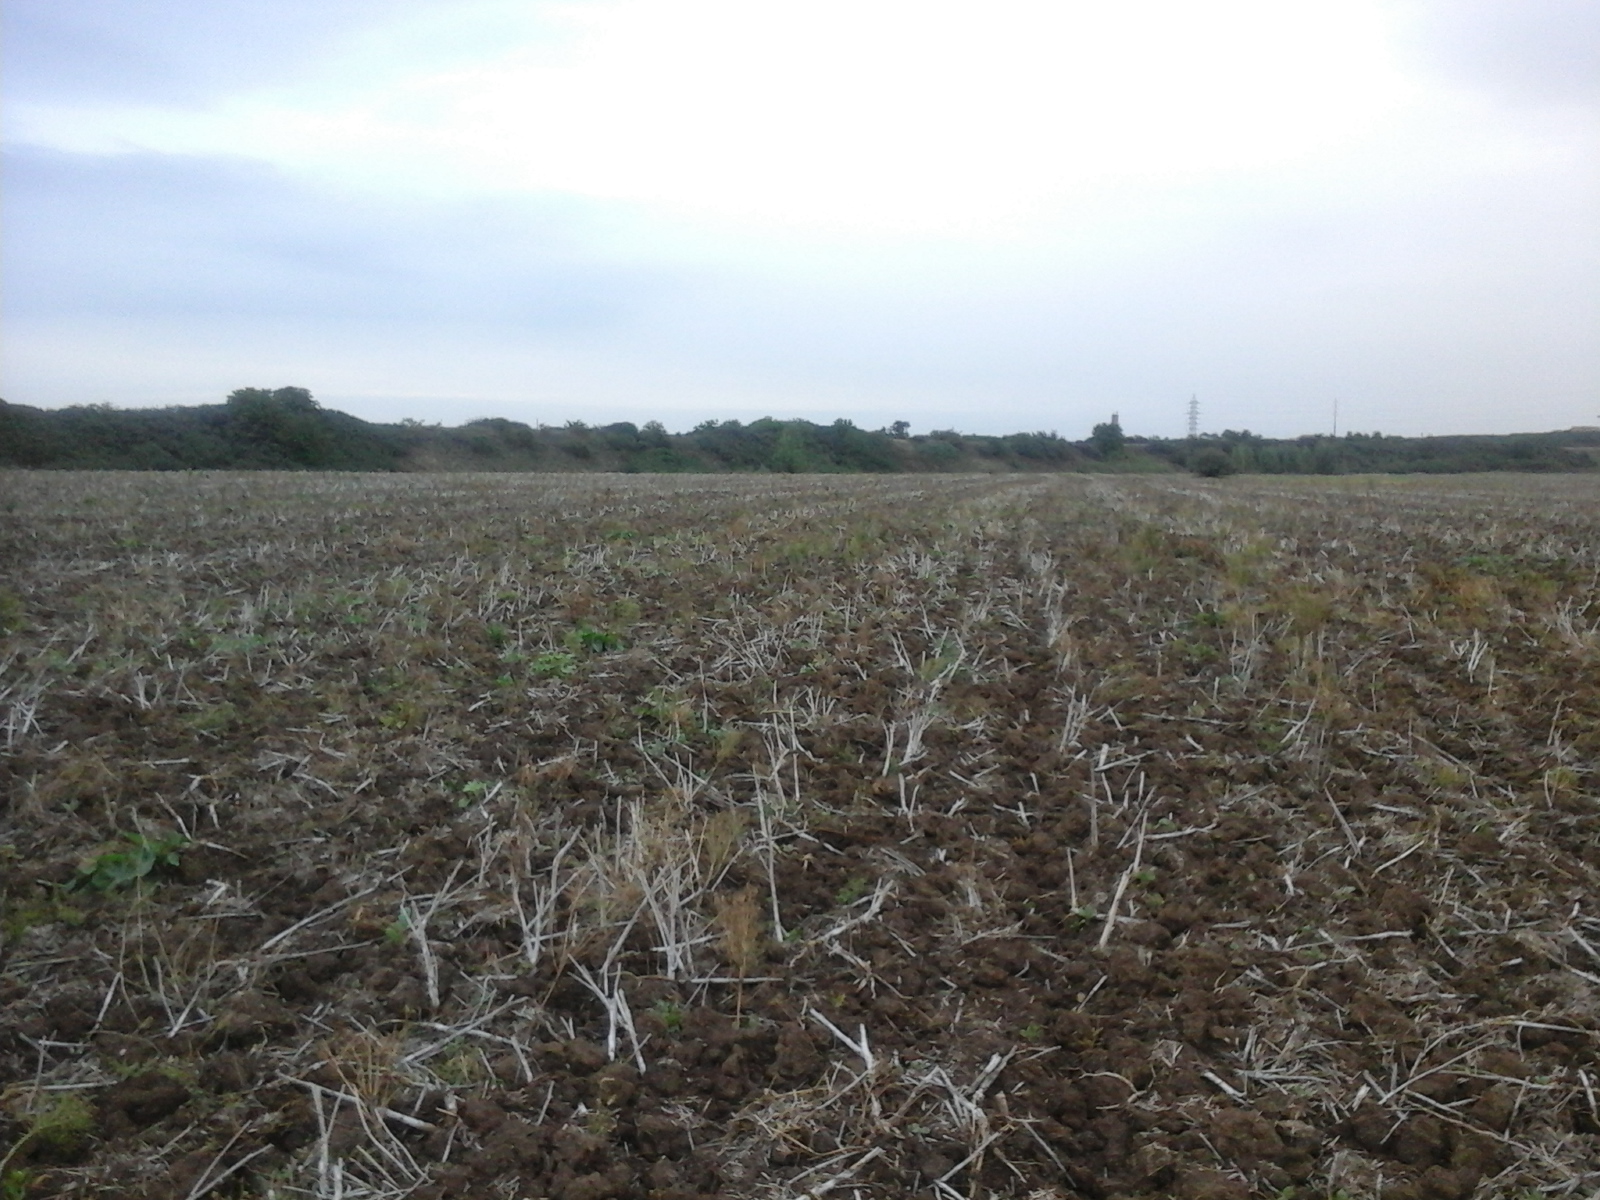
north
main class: Cropland
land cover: Rape and turnip rape
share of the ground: < 10 %
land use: Agriculture (excluding fallow land and kitchen gardens)
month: September
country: RO
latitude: 47.1221
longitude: 21.8960
